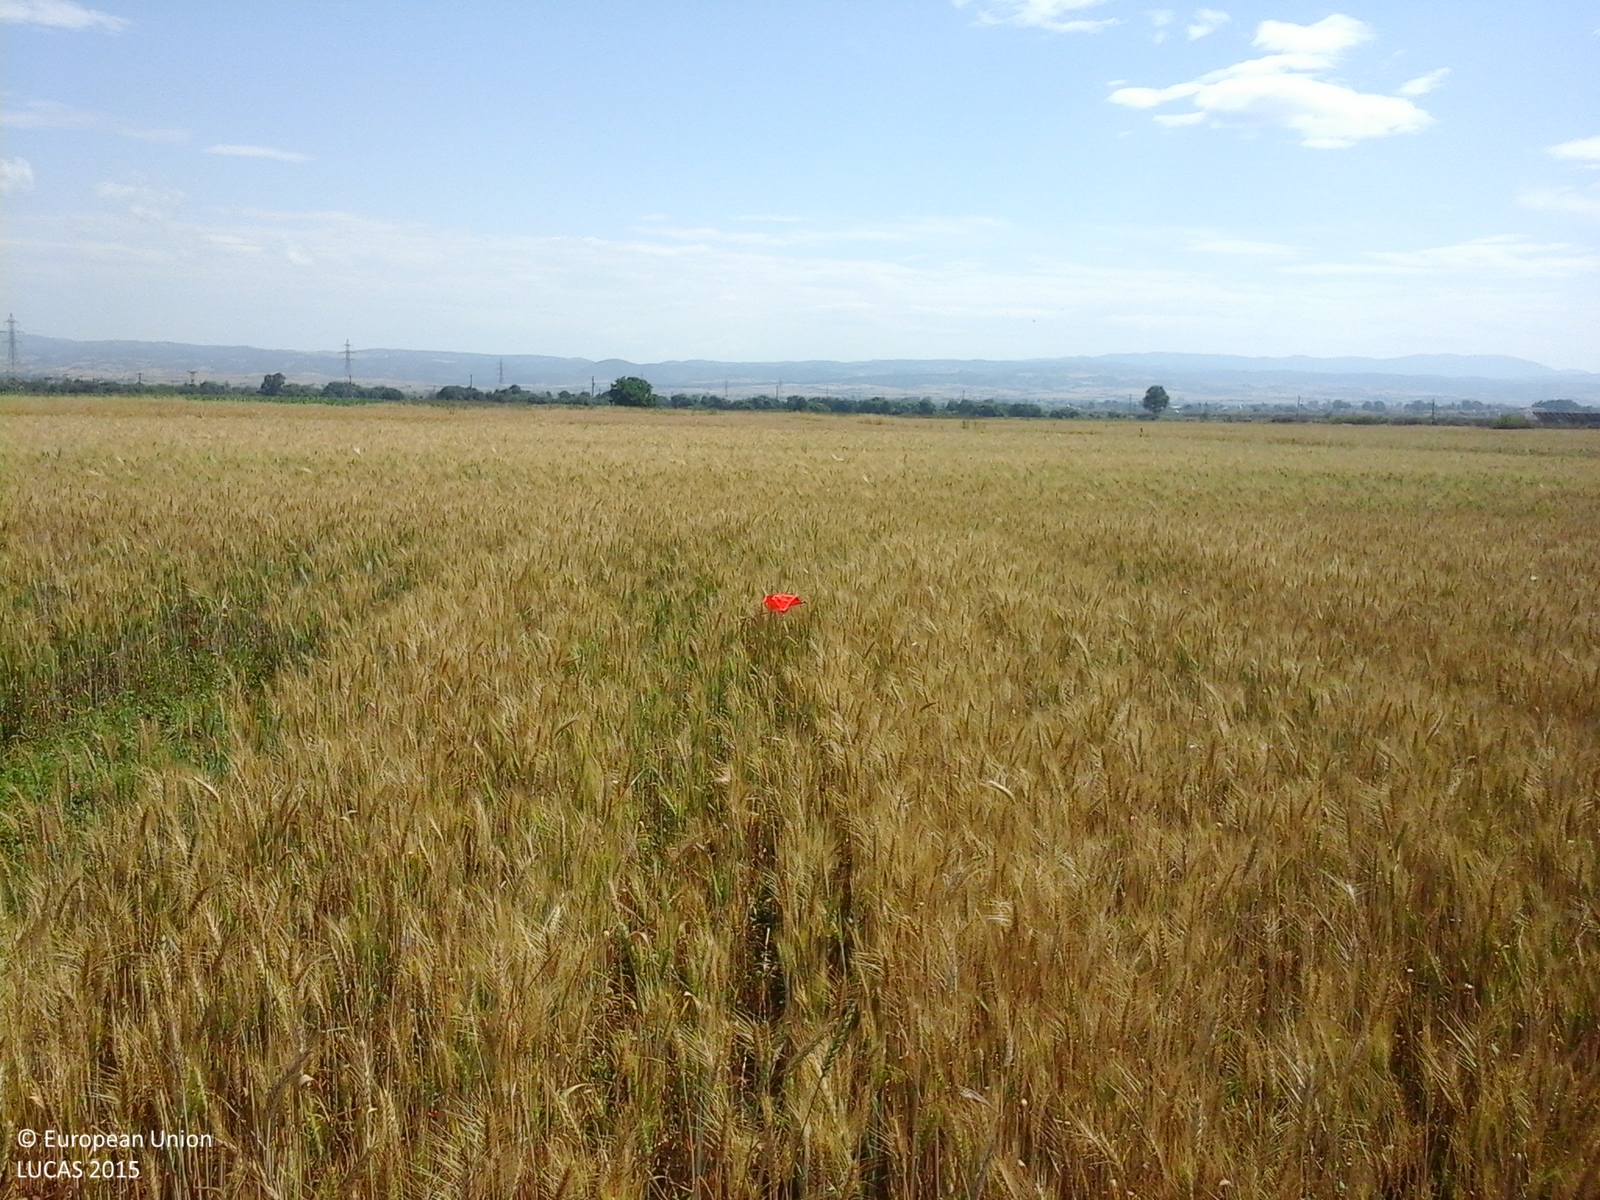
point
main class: Cropland
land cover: Common wheat
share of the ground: > 75 %
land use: Agriculture (excluding fallow land and kitchen gardens)
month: June
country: GR
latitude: 40.7519
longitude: 23.0023
